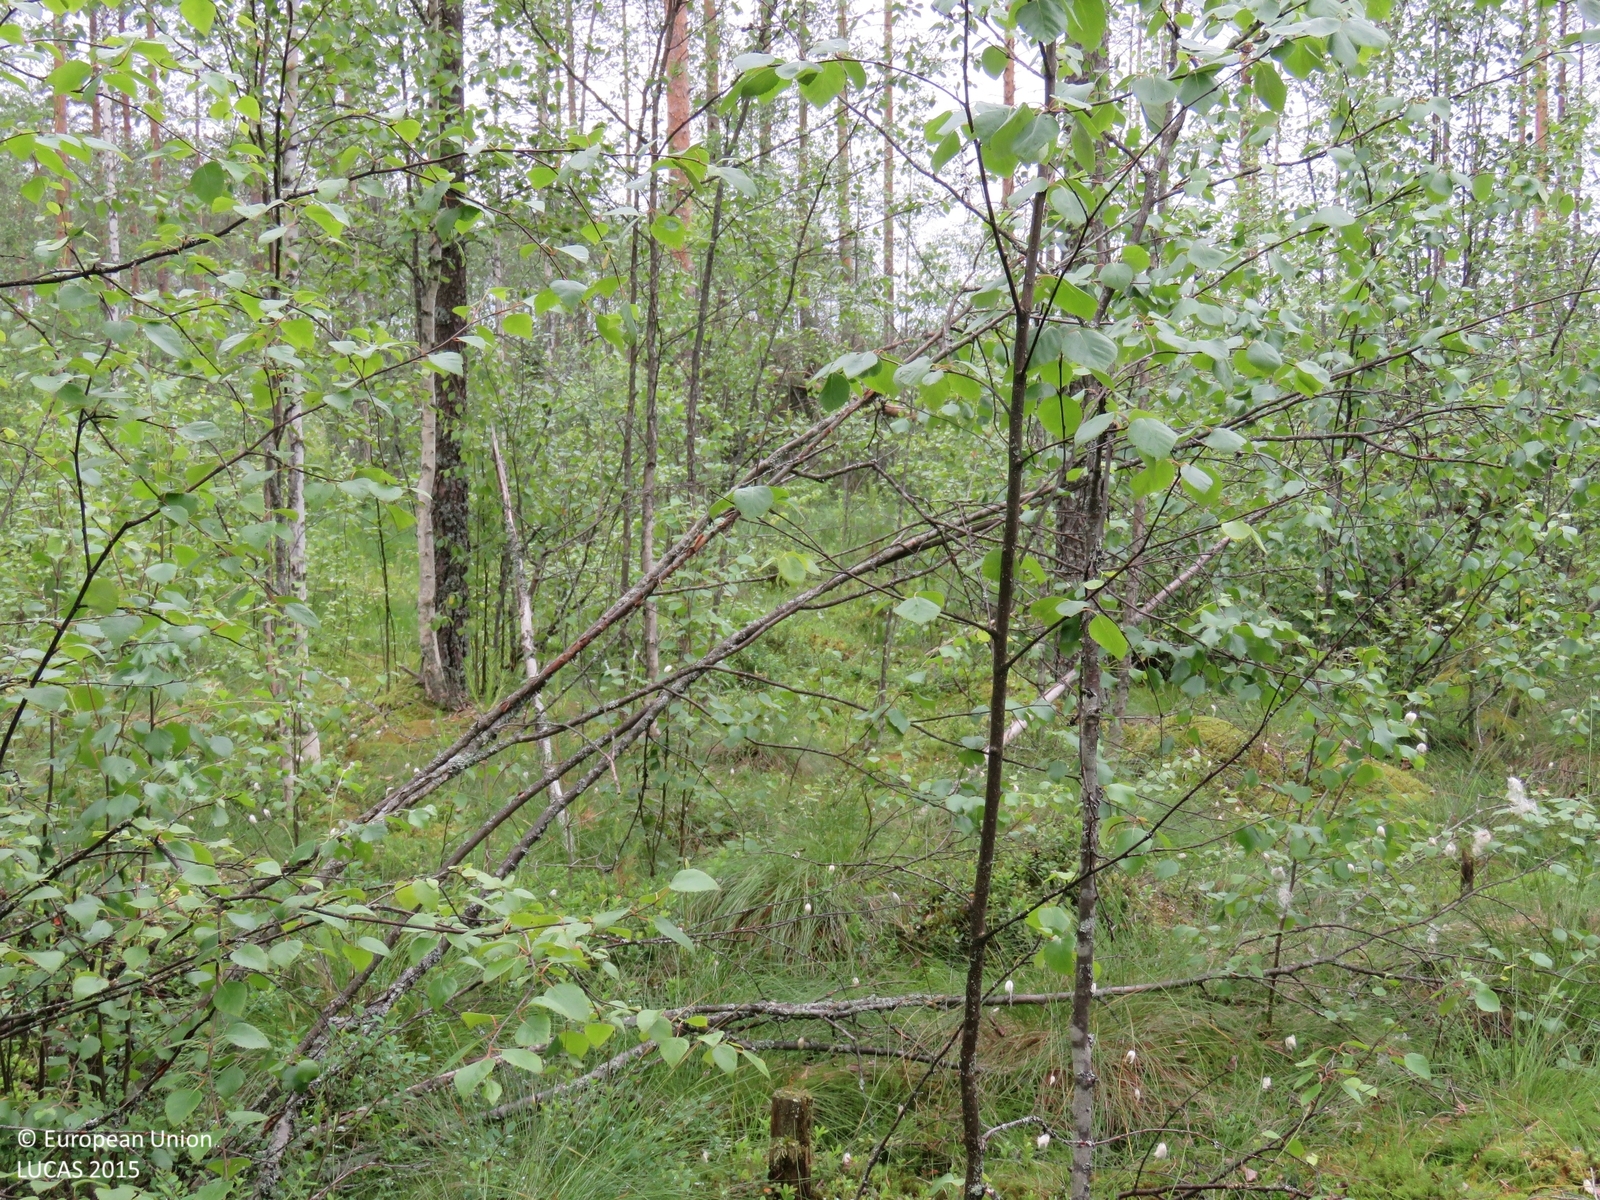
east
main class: Woodland
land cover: Pine dominated mixed woodland
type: boreal forest
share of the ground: > 75 %
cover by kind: broadleaved forest trees 50 %, coniferous forest trees 40 %, shrubs 5 %, herbaceous plants 5 %
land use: Forestry
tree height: > 5 m
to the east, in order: Pine dominated mixed woodland; Ditches and canals; Inland marshes; Pine dominated mixed woodland; Ditches and canals; Shrubland with sparse tree cover; Grassland with sparse tree/shrub cover; Ditches and canals; Broadleaved woodland; Other bare soil
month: July
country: FI
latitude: 64.3939
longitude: 26.3499
